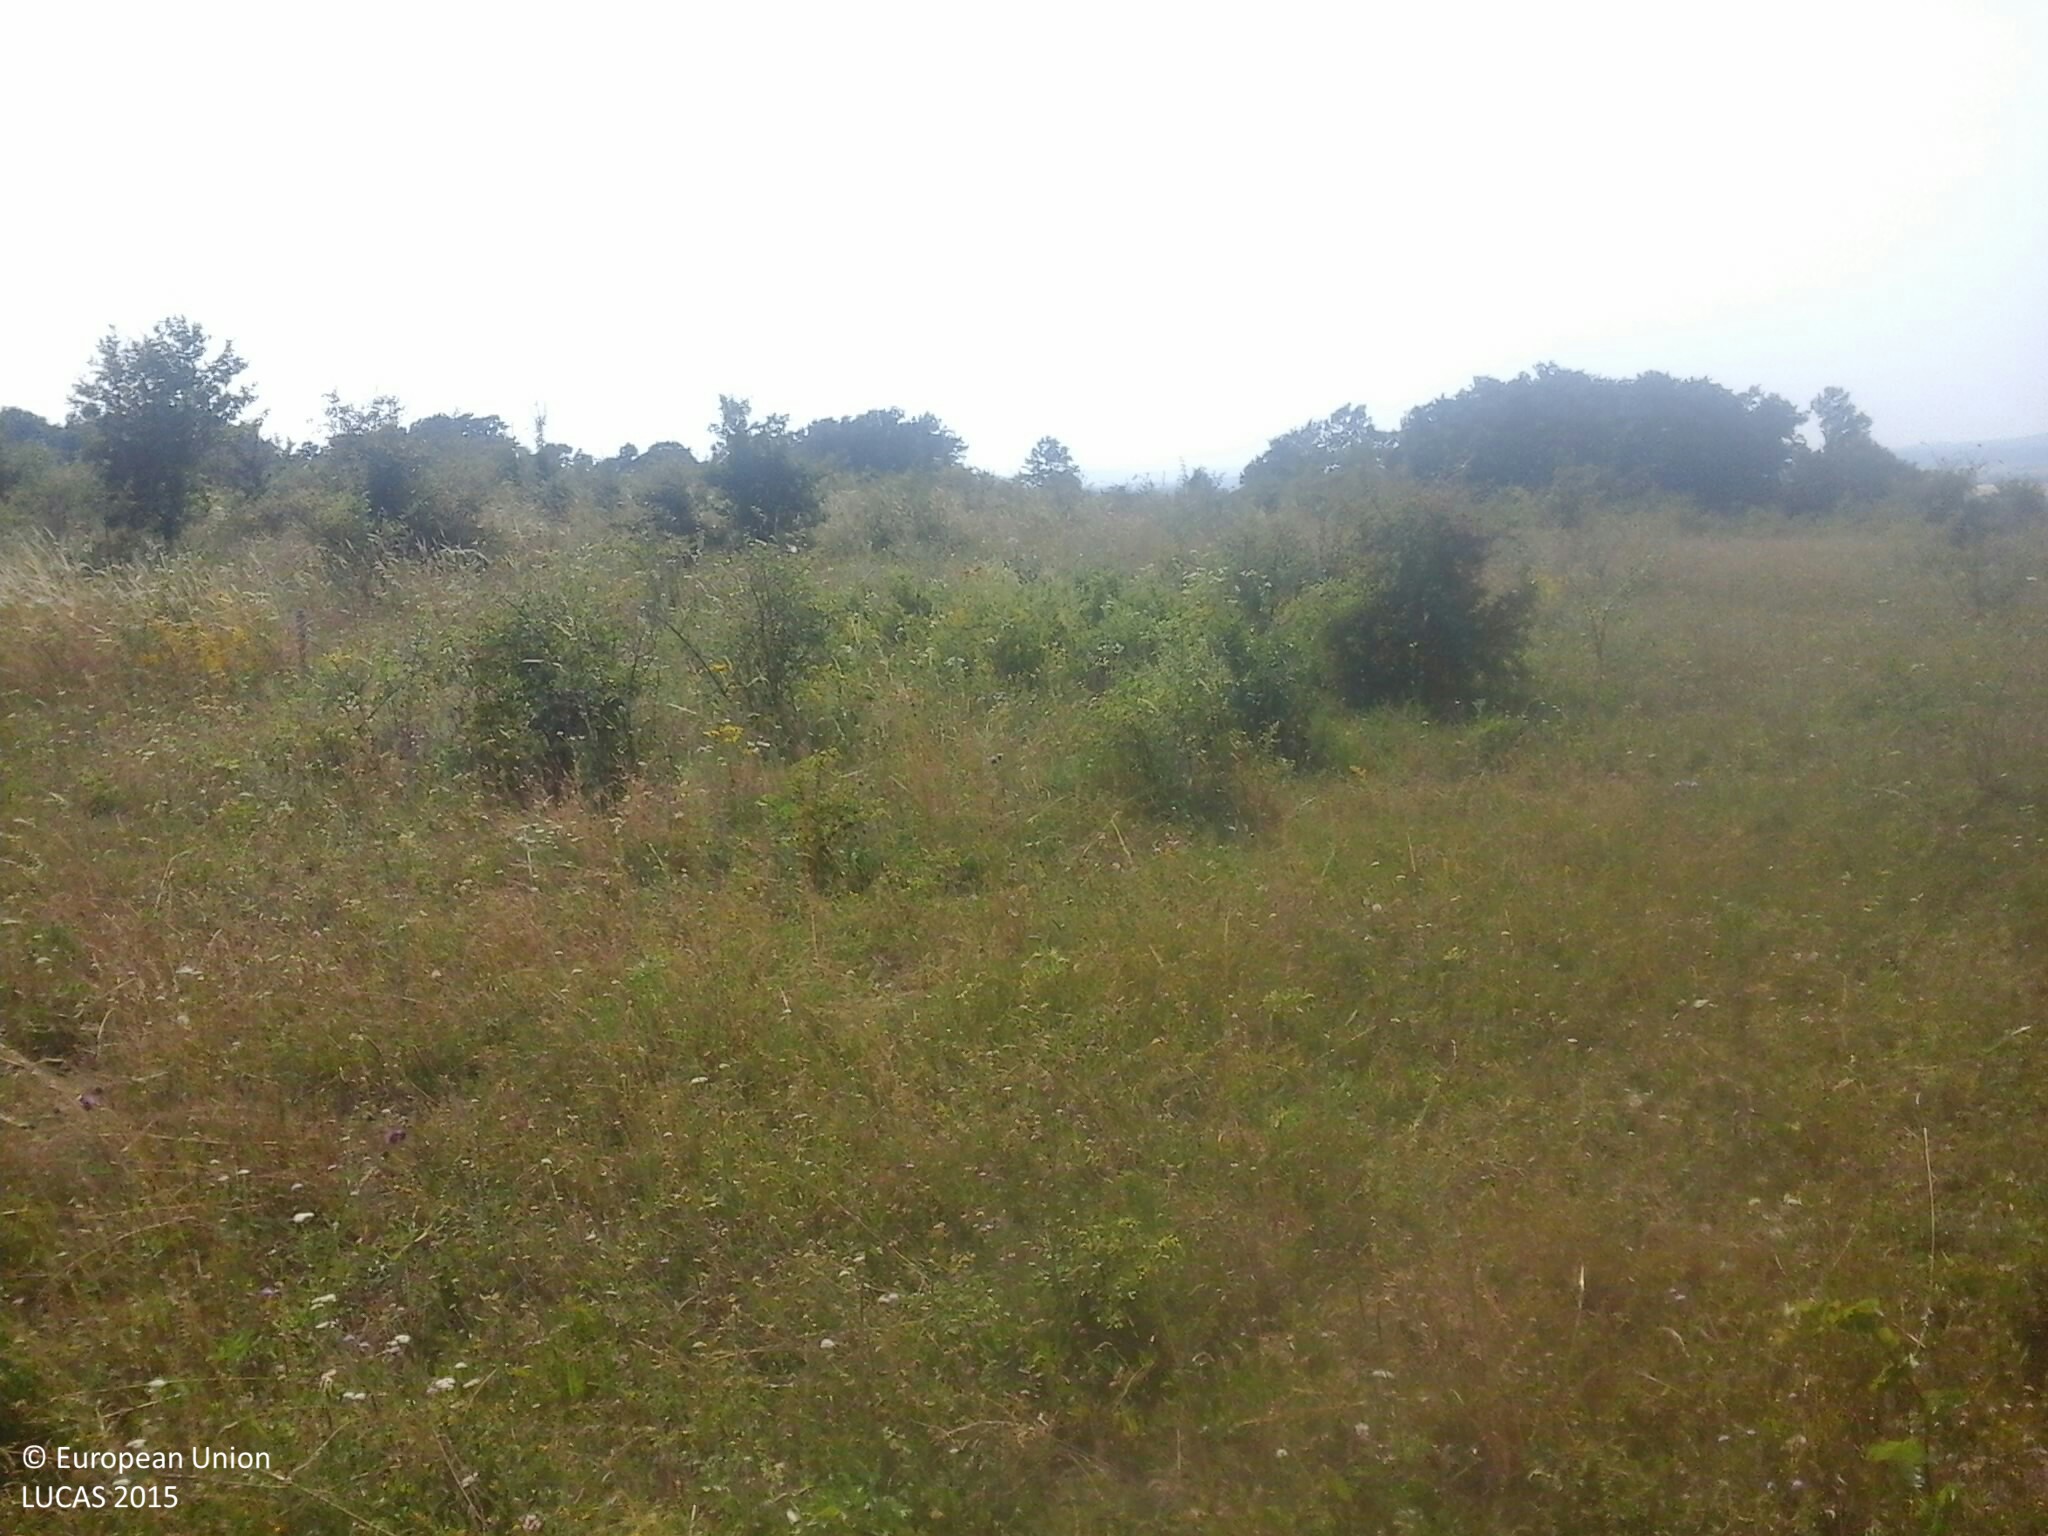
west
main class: Shrubland
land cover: Shrubland without tree cover
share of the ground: > 75 %
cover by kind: shrubs 95 %, herbaceous plants 5 %
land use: Semi-natural and natural areas not in use
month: July
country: HU
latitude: 46.9920
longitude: 17.7526
